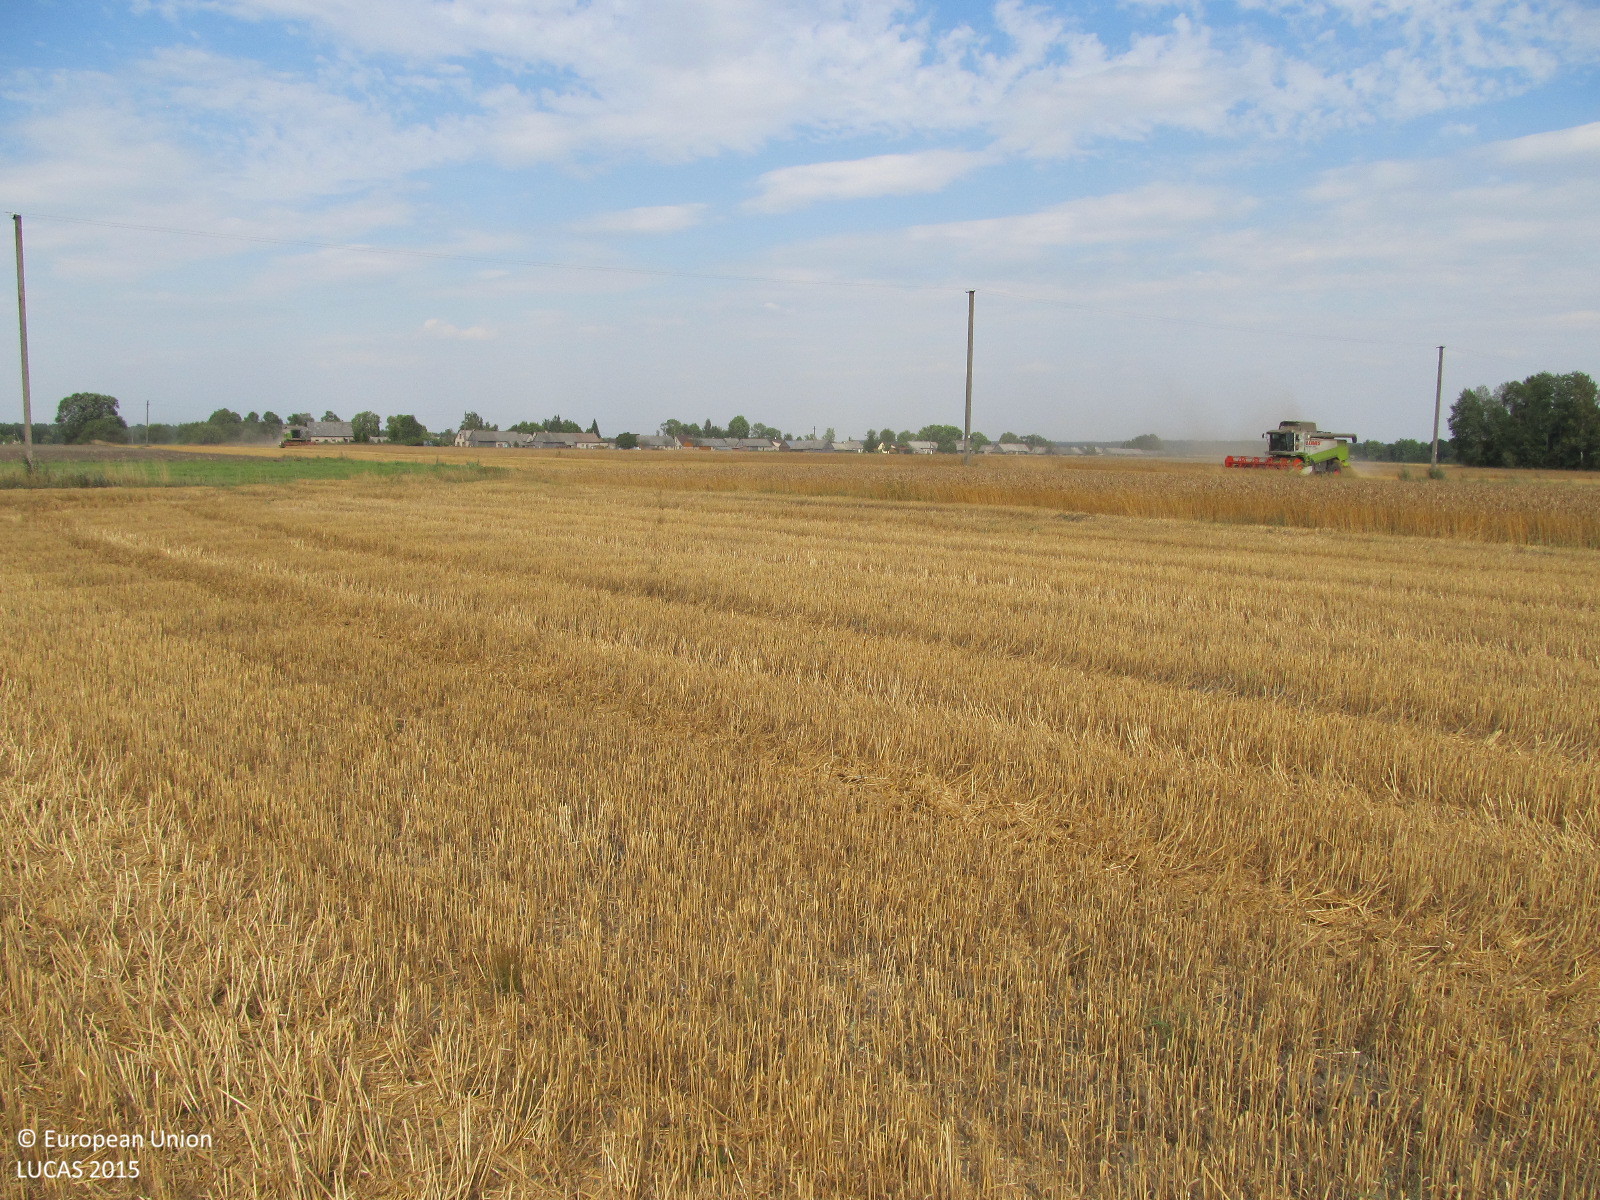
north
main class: Cropland
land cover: Barley
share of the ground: > 75 %
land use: Agriculture (excluding fallow land and kitchen gardens)
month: August
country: LT
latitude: 55.6627
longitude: 23.0575
